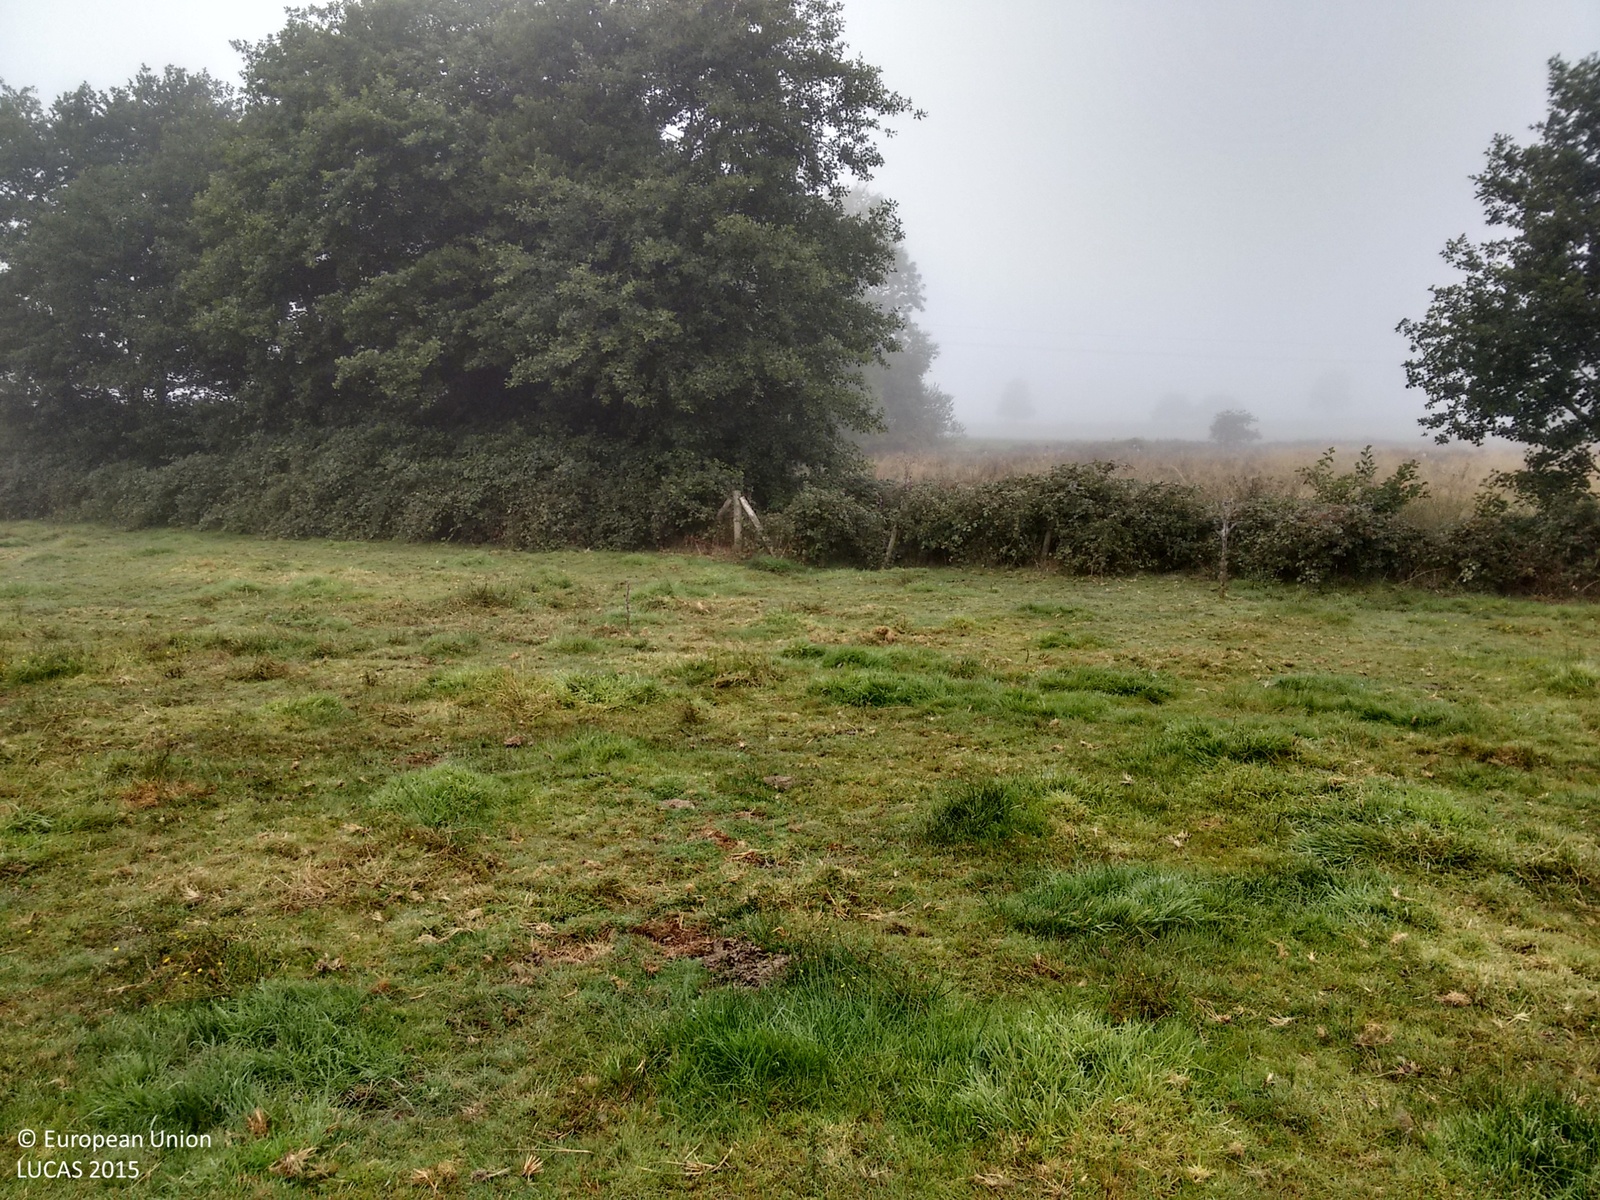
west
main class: Grassland
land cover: Grassland without tree/shrub cover
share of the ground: > 75 %
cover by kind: herbaceous plants 100 %
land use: Agriculture (excluding fallow land and kitchen gardens)
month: September
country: GB
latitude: 52.8135
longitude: -2.9371
